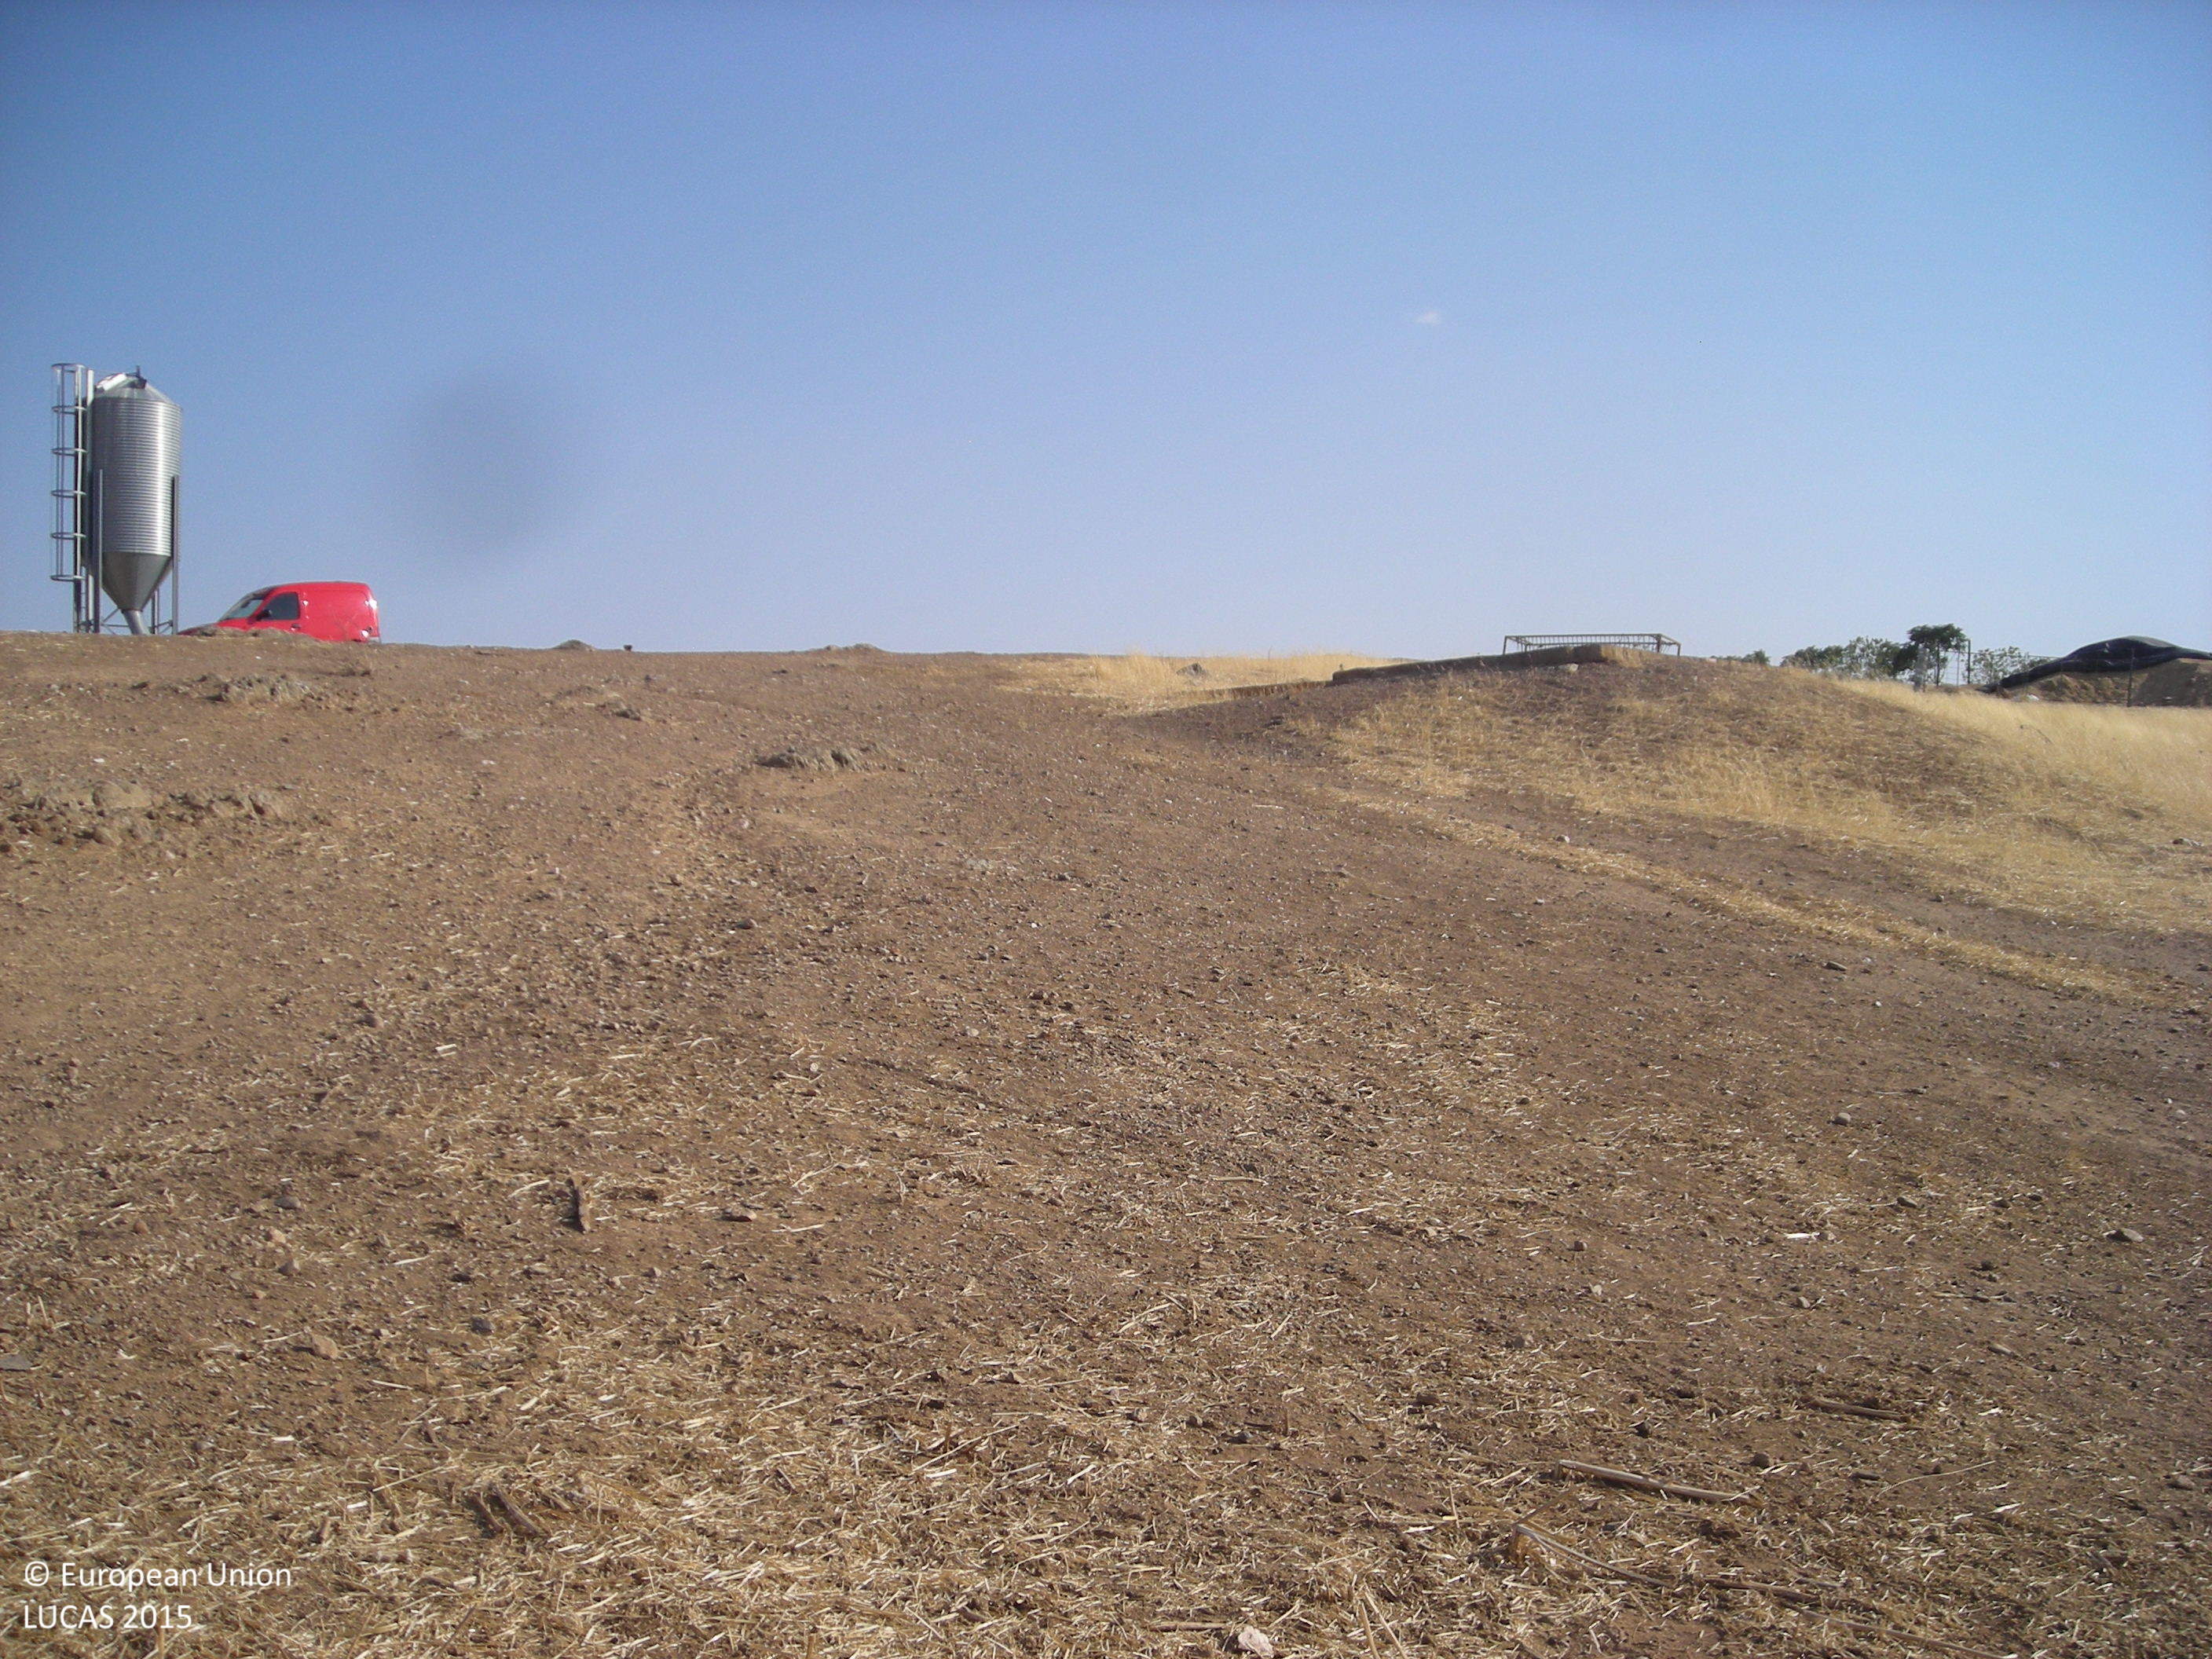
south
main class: Grassland
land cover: Grassland without tree/shrub cover
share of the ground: > 75 %
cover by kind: herbaceous plants 100 %
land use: Agriculture (excluding fallow land and kitchen gardens)
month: July
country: ES
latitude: 38.8837
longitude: -5.4772
